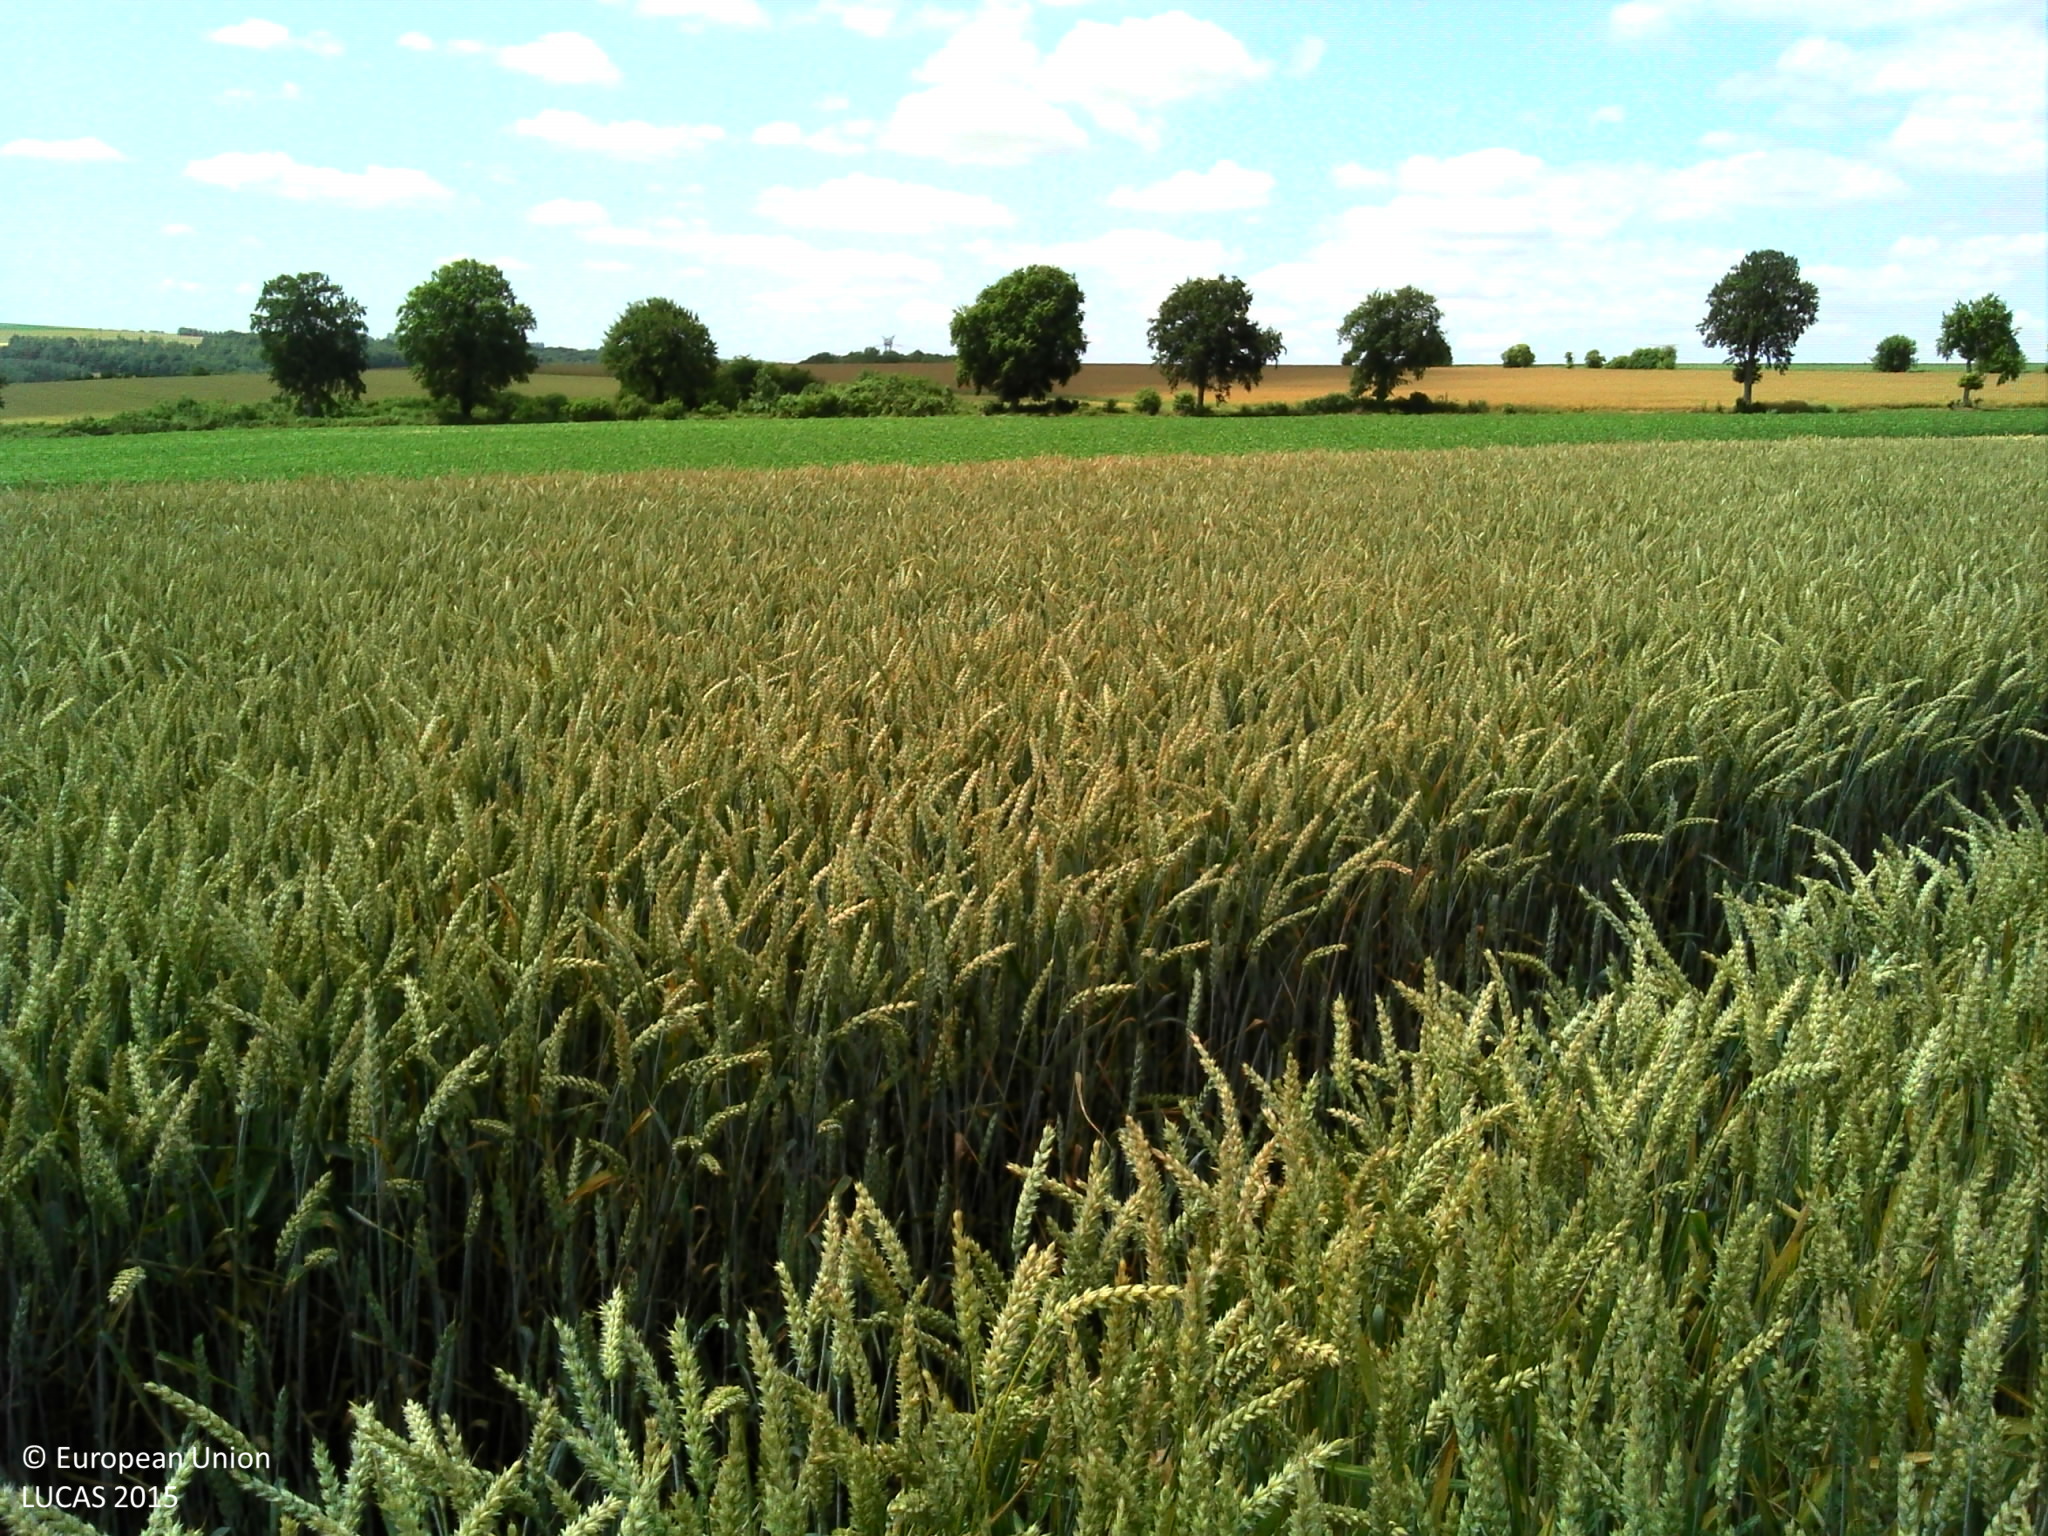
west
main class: Cropland
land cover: Common wheat
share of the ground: > 75 %
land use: Agriculture (excluding fallow land and kitchen gardens)
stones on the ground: 10 - 25 %
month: July
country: FR
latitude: 50.3297
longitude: 2.1608
